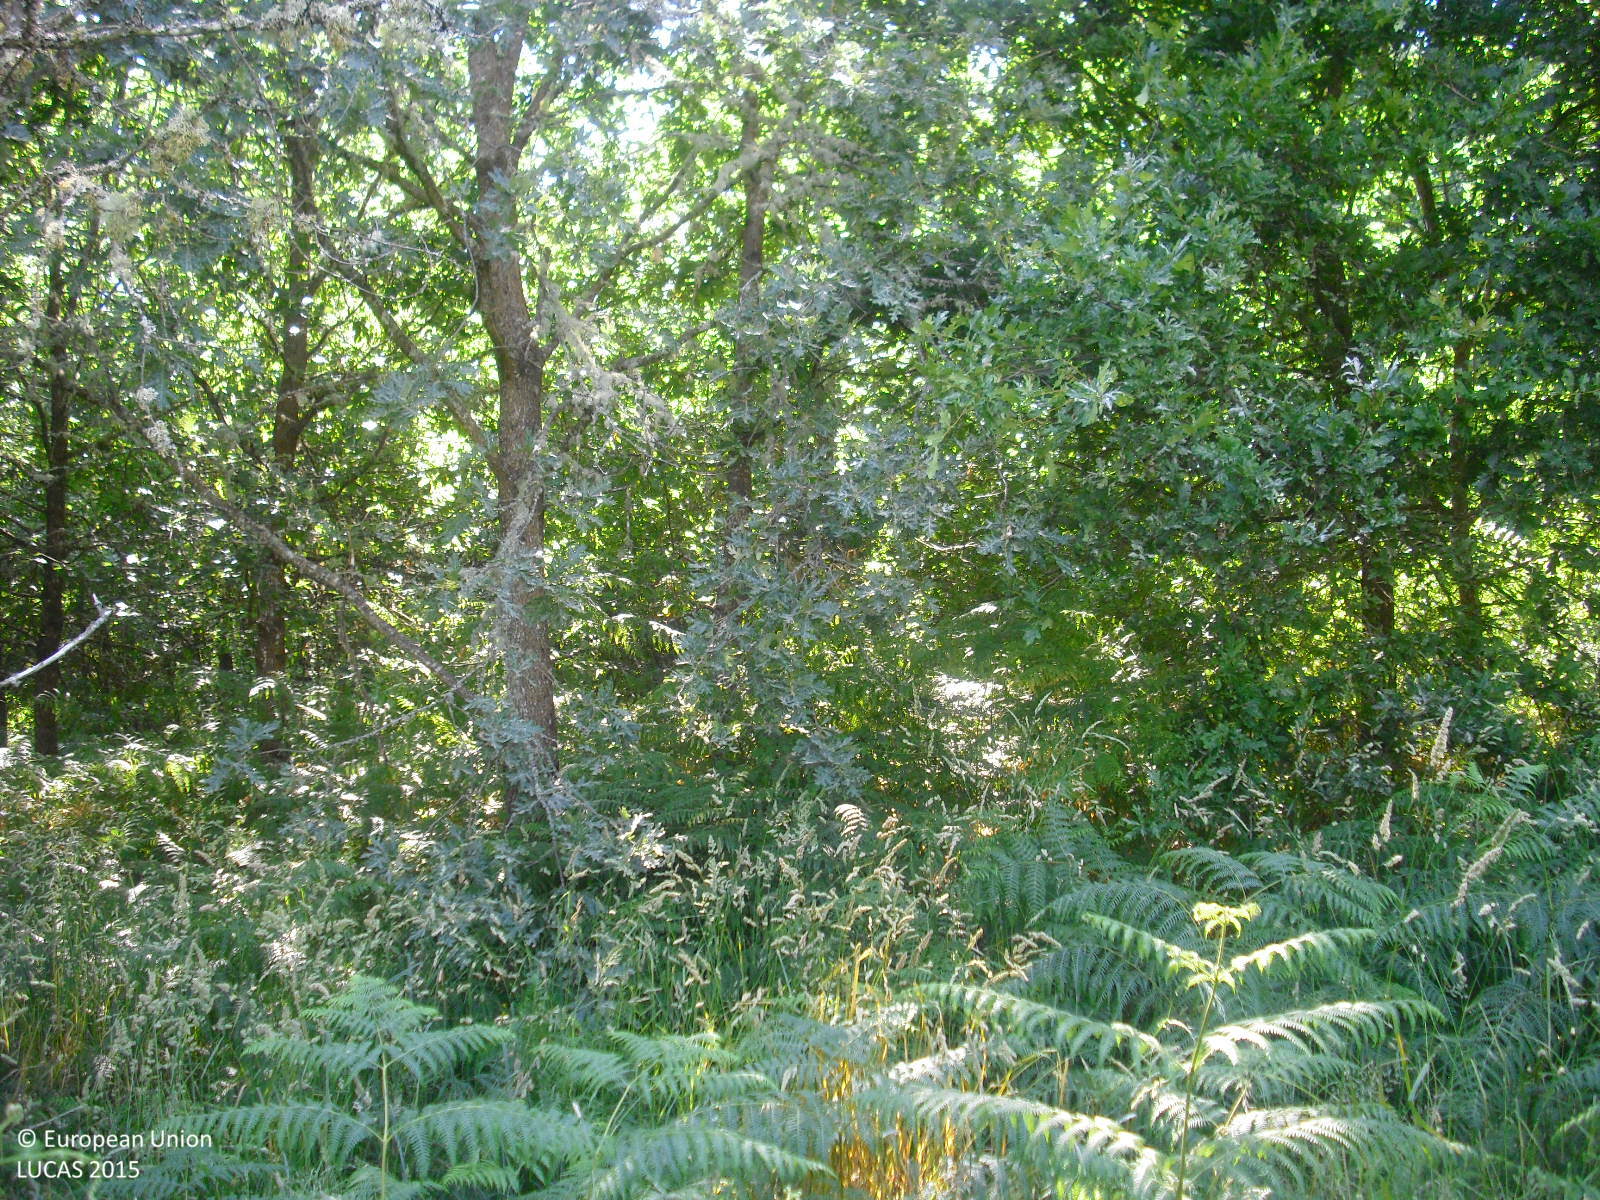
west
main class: Shrubland
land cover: Shrubland with sparse tree cover
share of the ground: 50 - 75 %
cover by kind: shrubs 70 %, herbaceous plants 25 %, broadleaved forest trees 5 %
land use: Abandoned areas
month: June
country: ES
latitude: 42.3997
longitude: -7.8518
